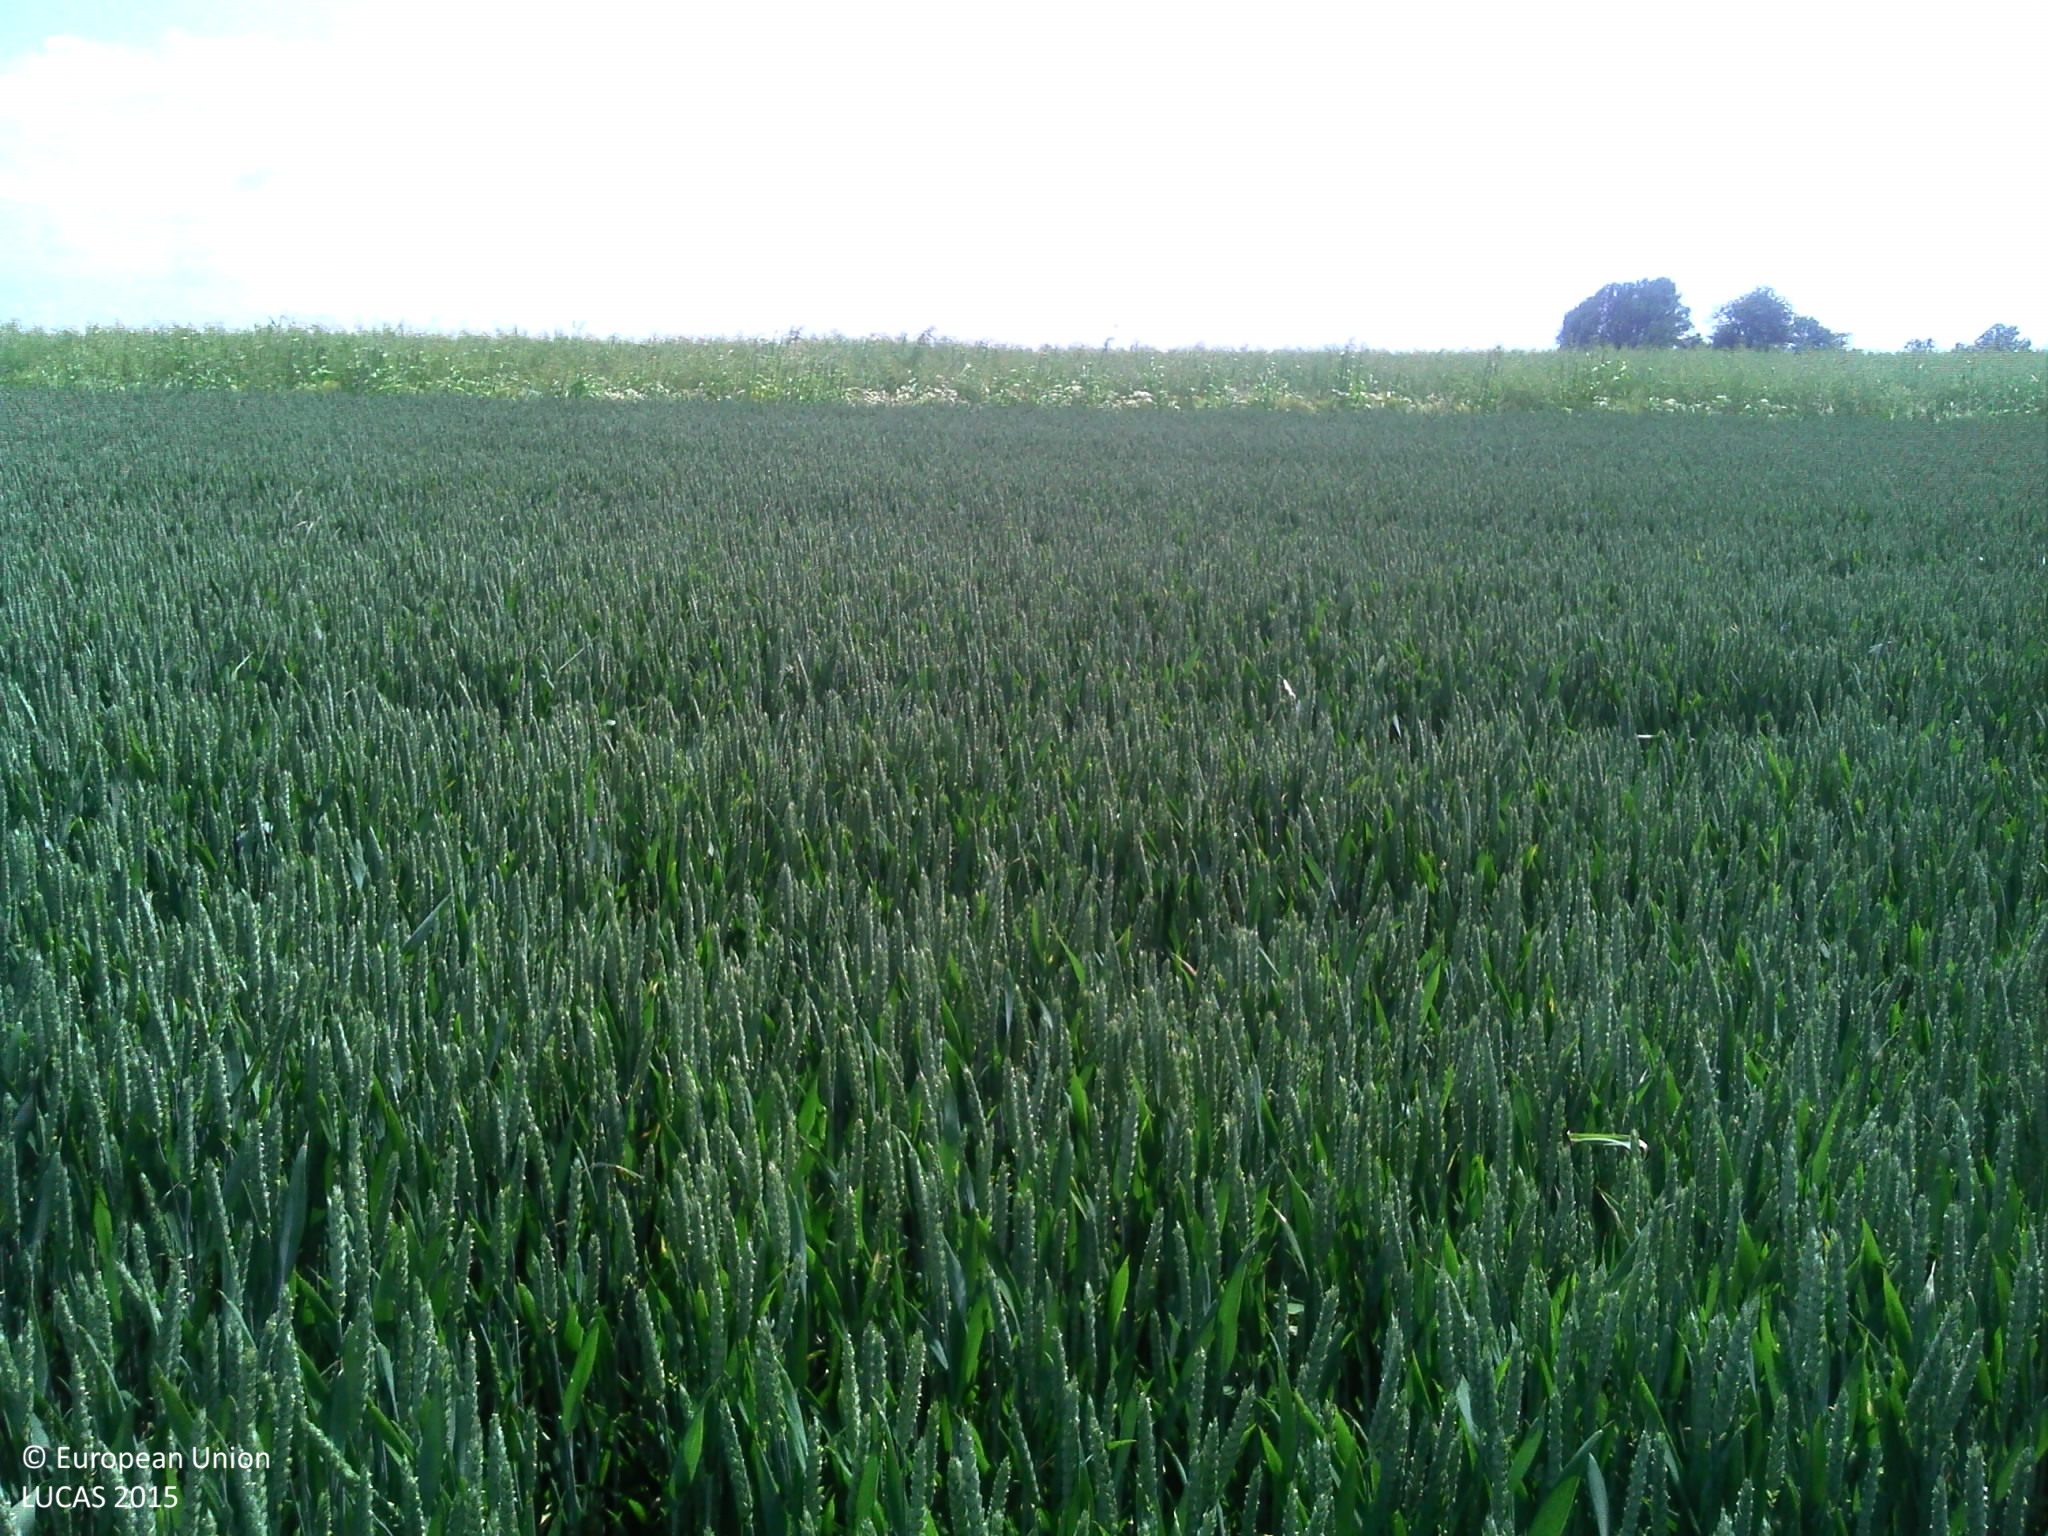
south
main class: Cropland
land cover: Common wheat
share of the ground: > 75 %
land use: Agriculture (excluding fallow land and kitchen gardens)
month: June
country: FR
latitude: 49.7471
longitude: 4.1802
